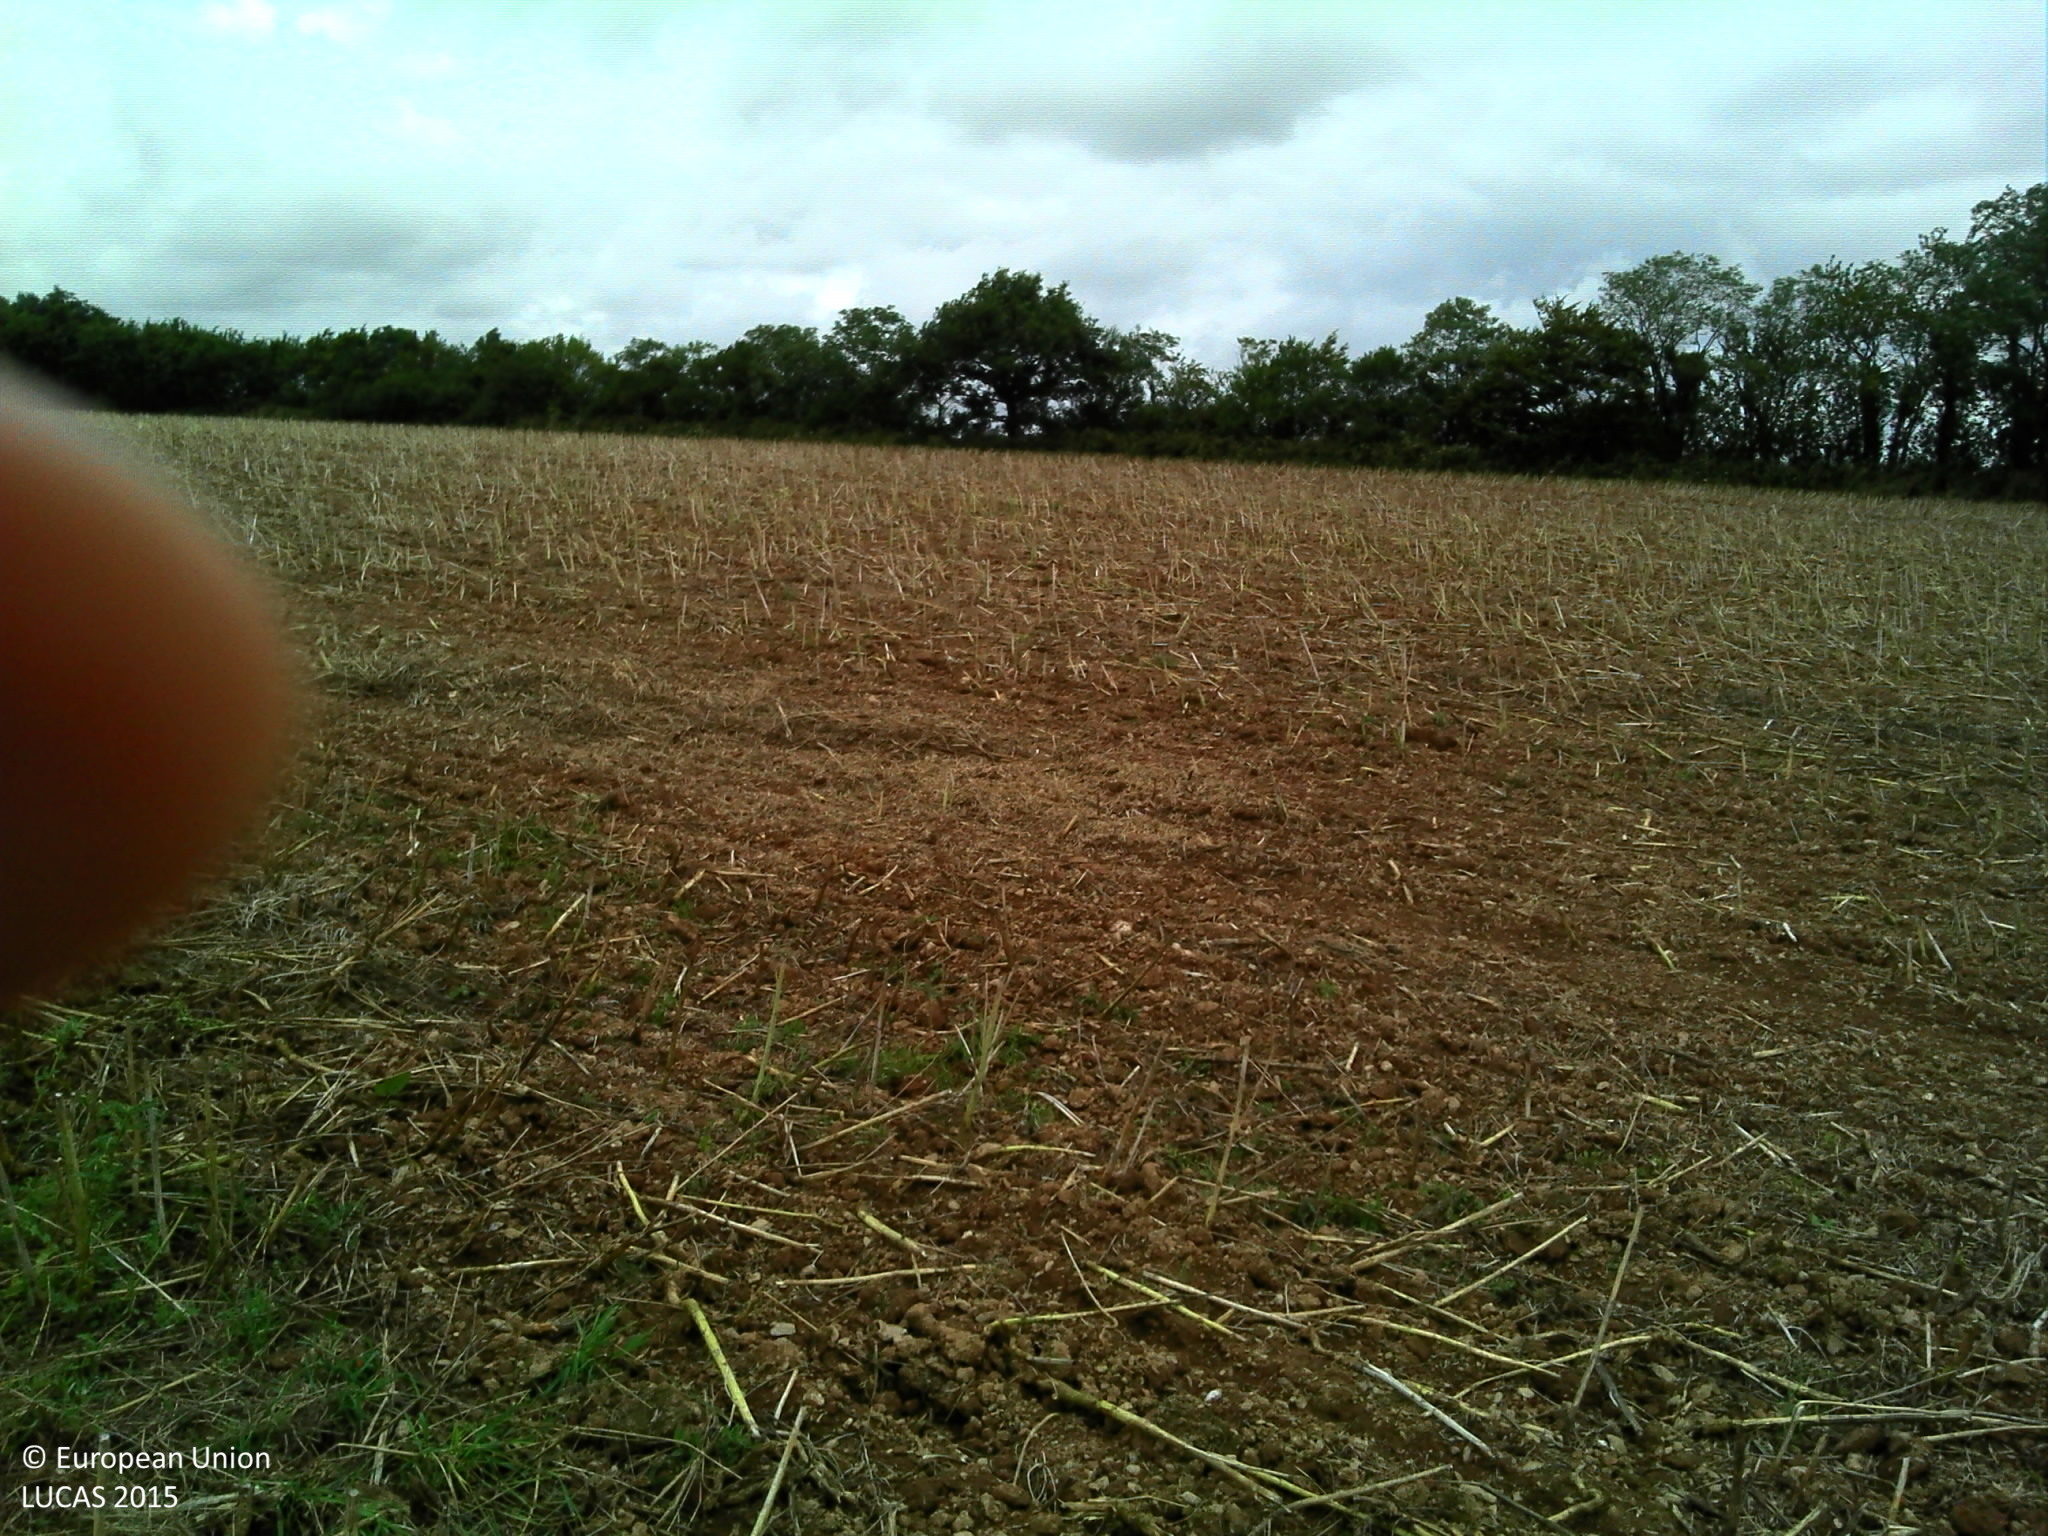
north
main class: Cropland
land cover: Rape and turnip rape
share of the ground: < 10 %
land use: Agriculture (excluding fallow land and kitchen gardens)
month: July
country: FR
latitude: 47.5122
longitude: -1.9866
